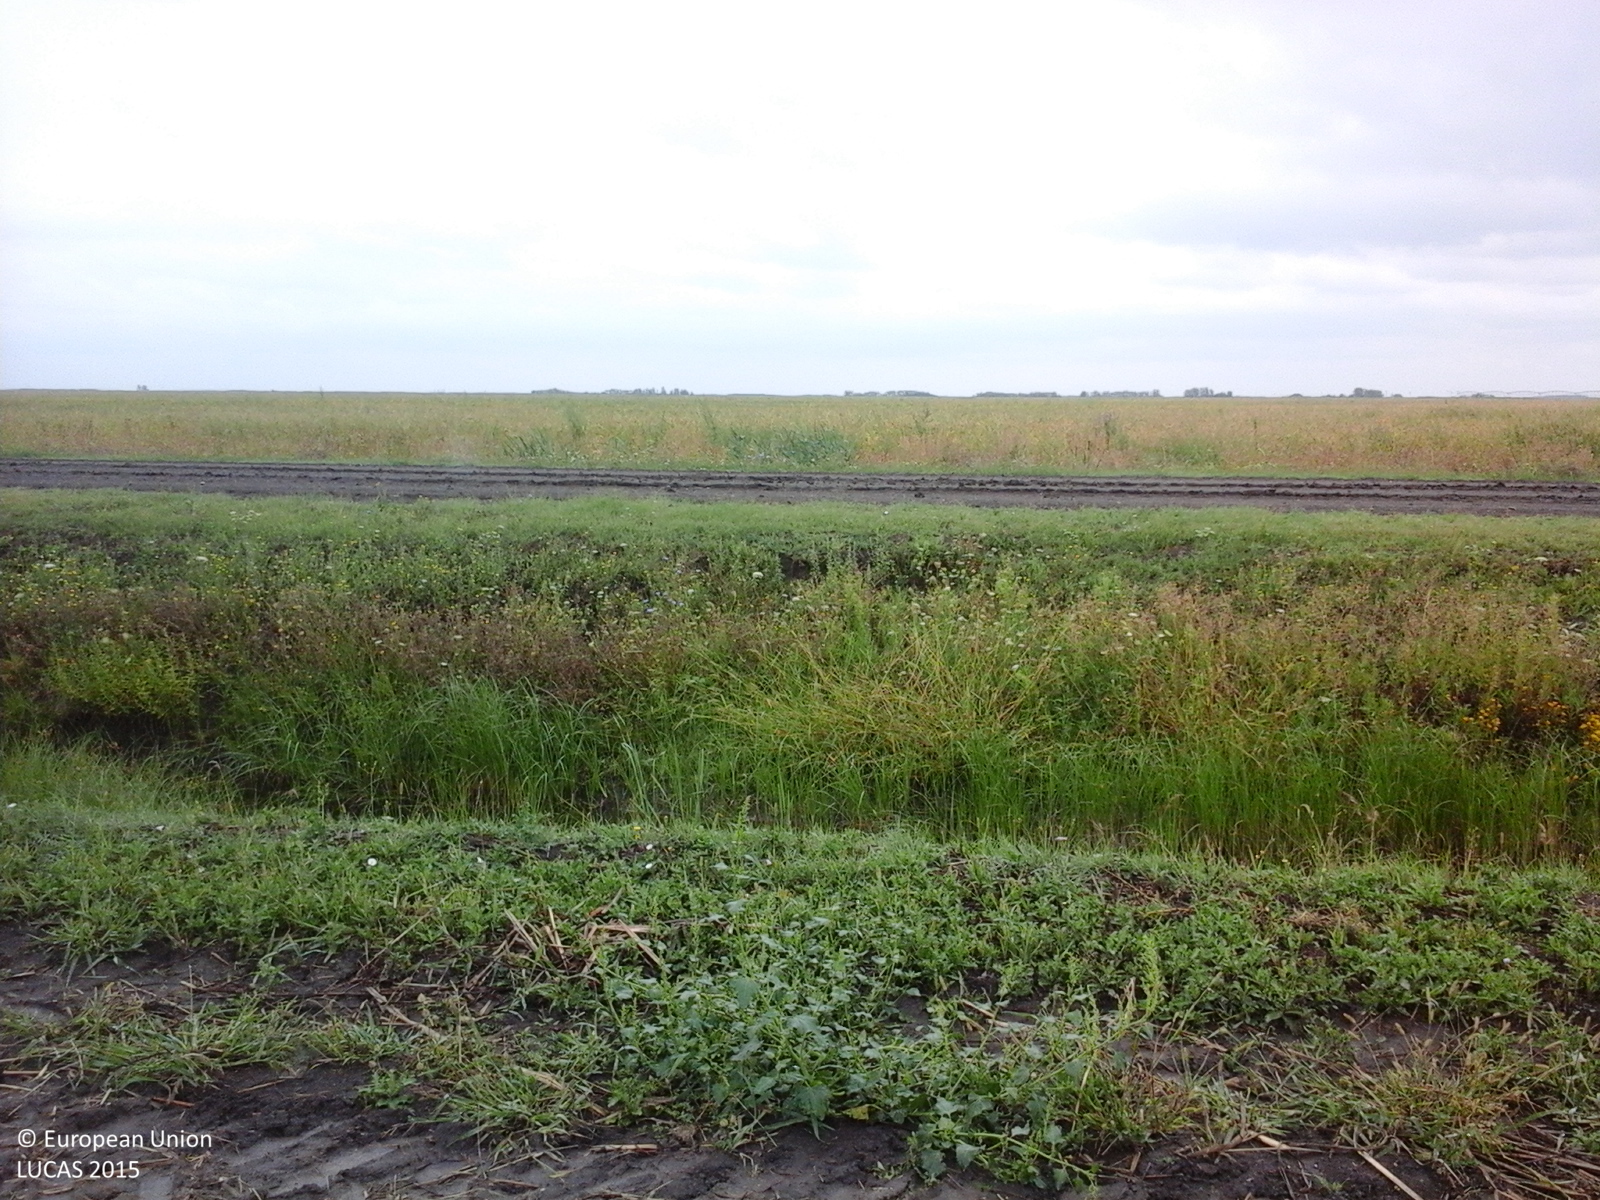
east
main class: Cropland
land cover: Sugar beet
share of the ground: > 75 %
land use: Agriculture (excluding fallow land and kitchen gardens)
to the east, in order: Sugar beet
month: August
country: RO
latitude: 46.0629
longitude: 20.3778
